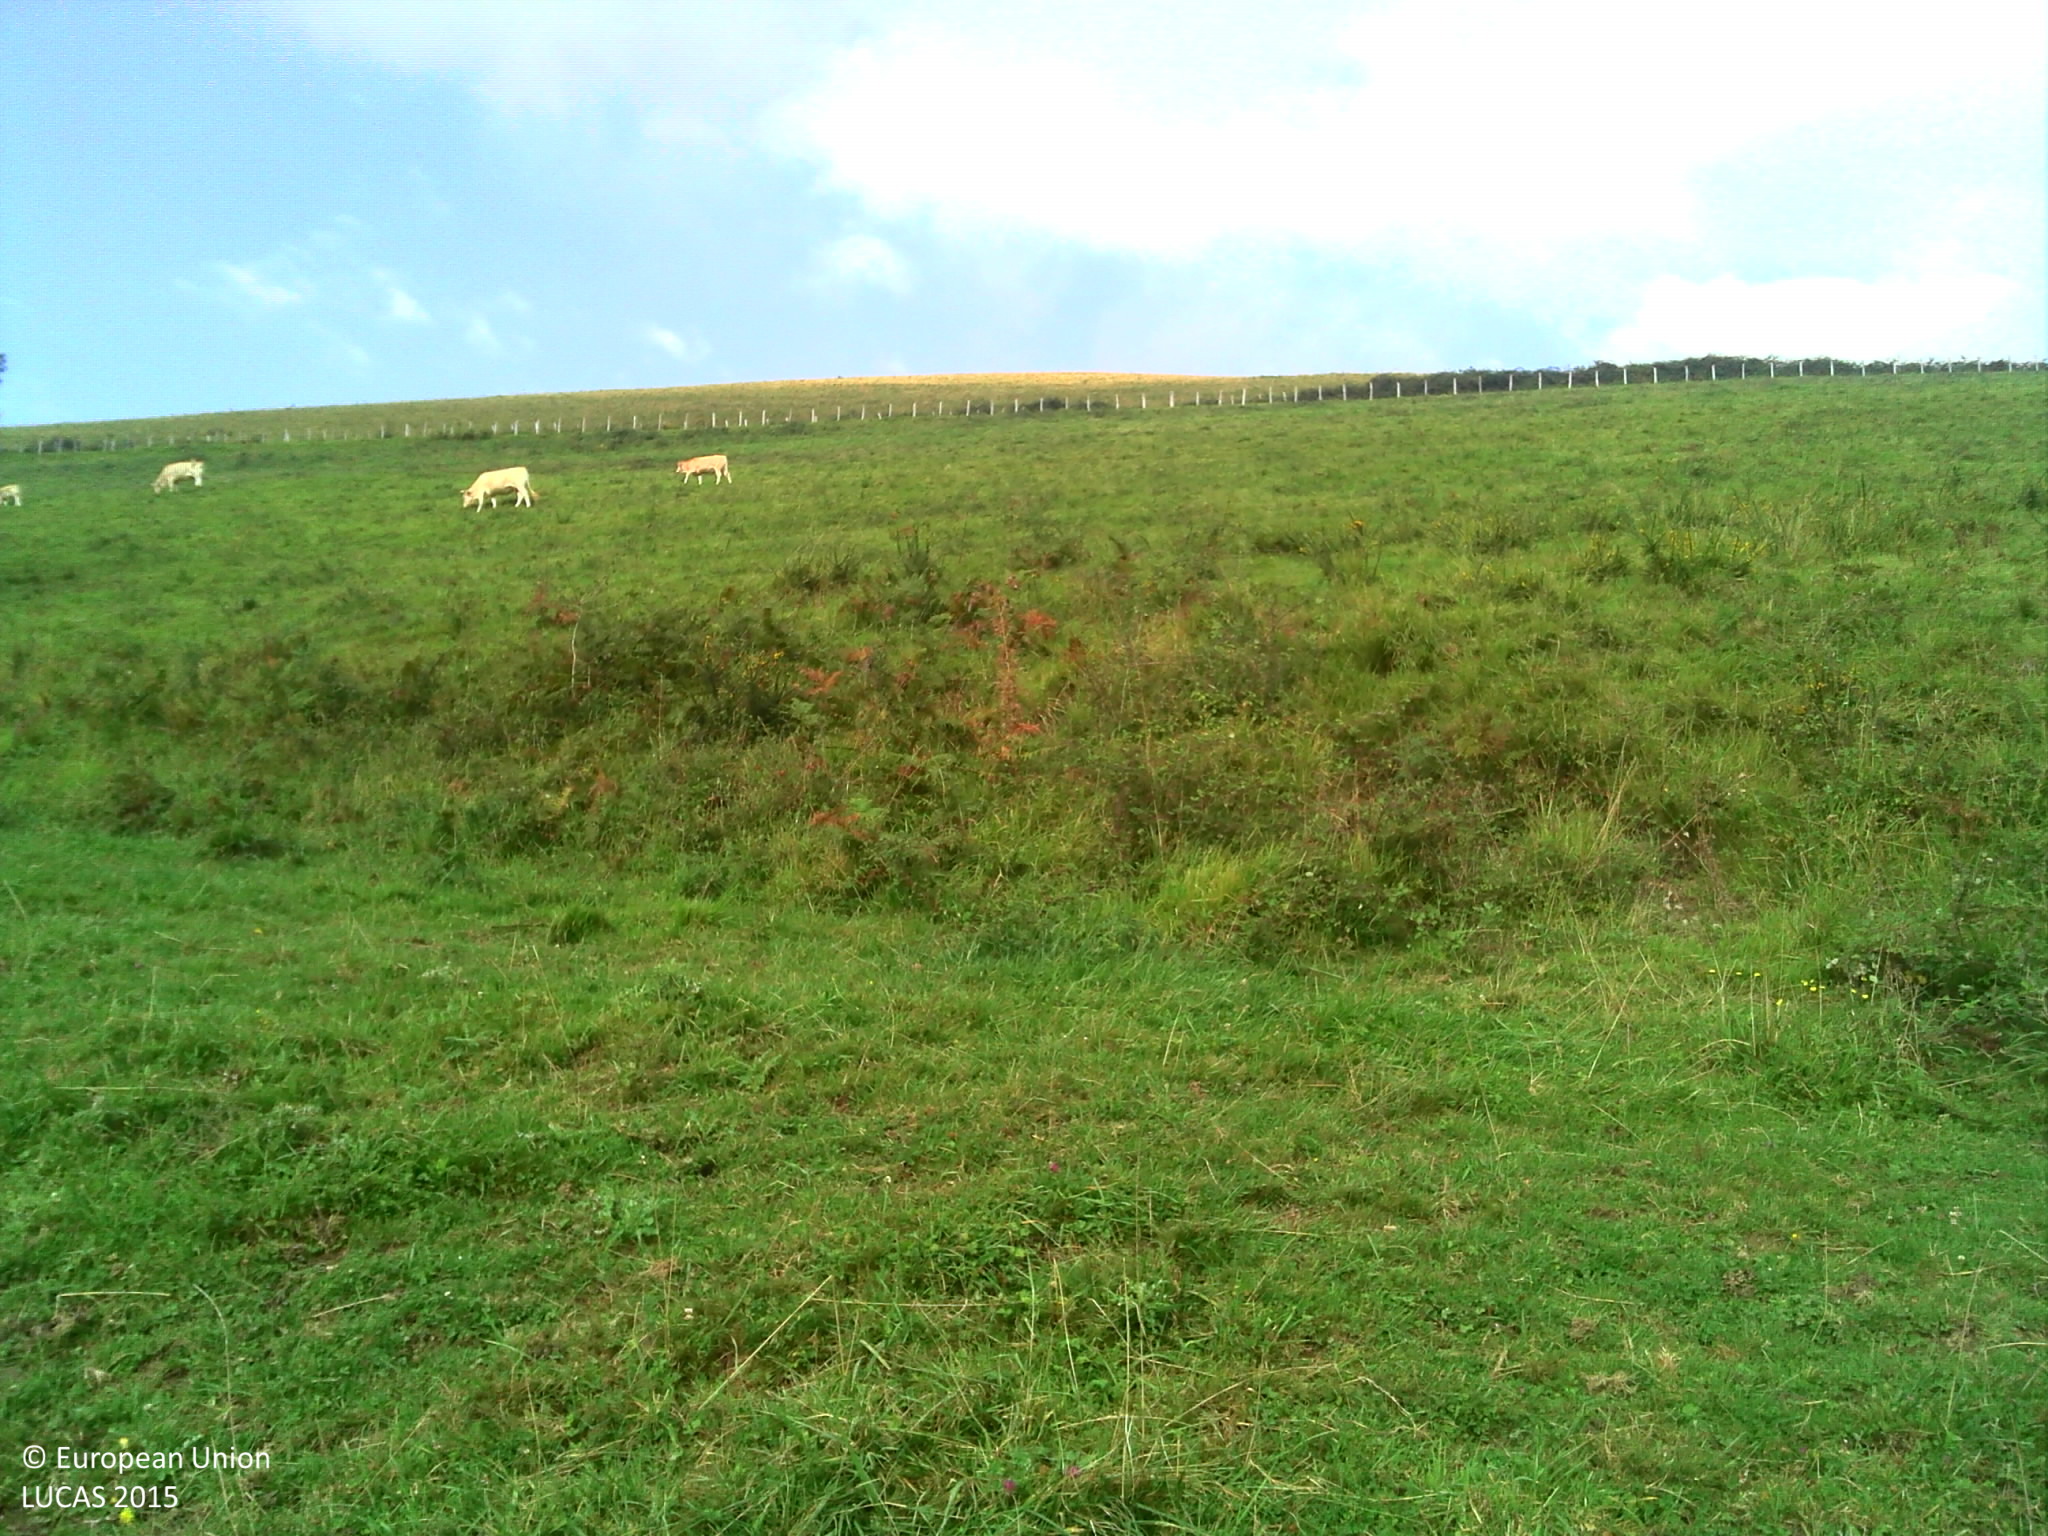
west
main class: Grassland
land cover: Grassland without tree/shrub cover
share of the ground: > 75 %
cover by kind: herbaceous plants 90 %, shrubs 5 %, consolidated bare surface 5 %
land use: Agriculture (excluding fallow land and kitchen gardens)
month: September
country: FR
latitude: 43.1865
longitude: -1.1230
